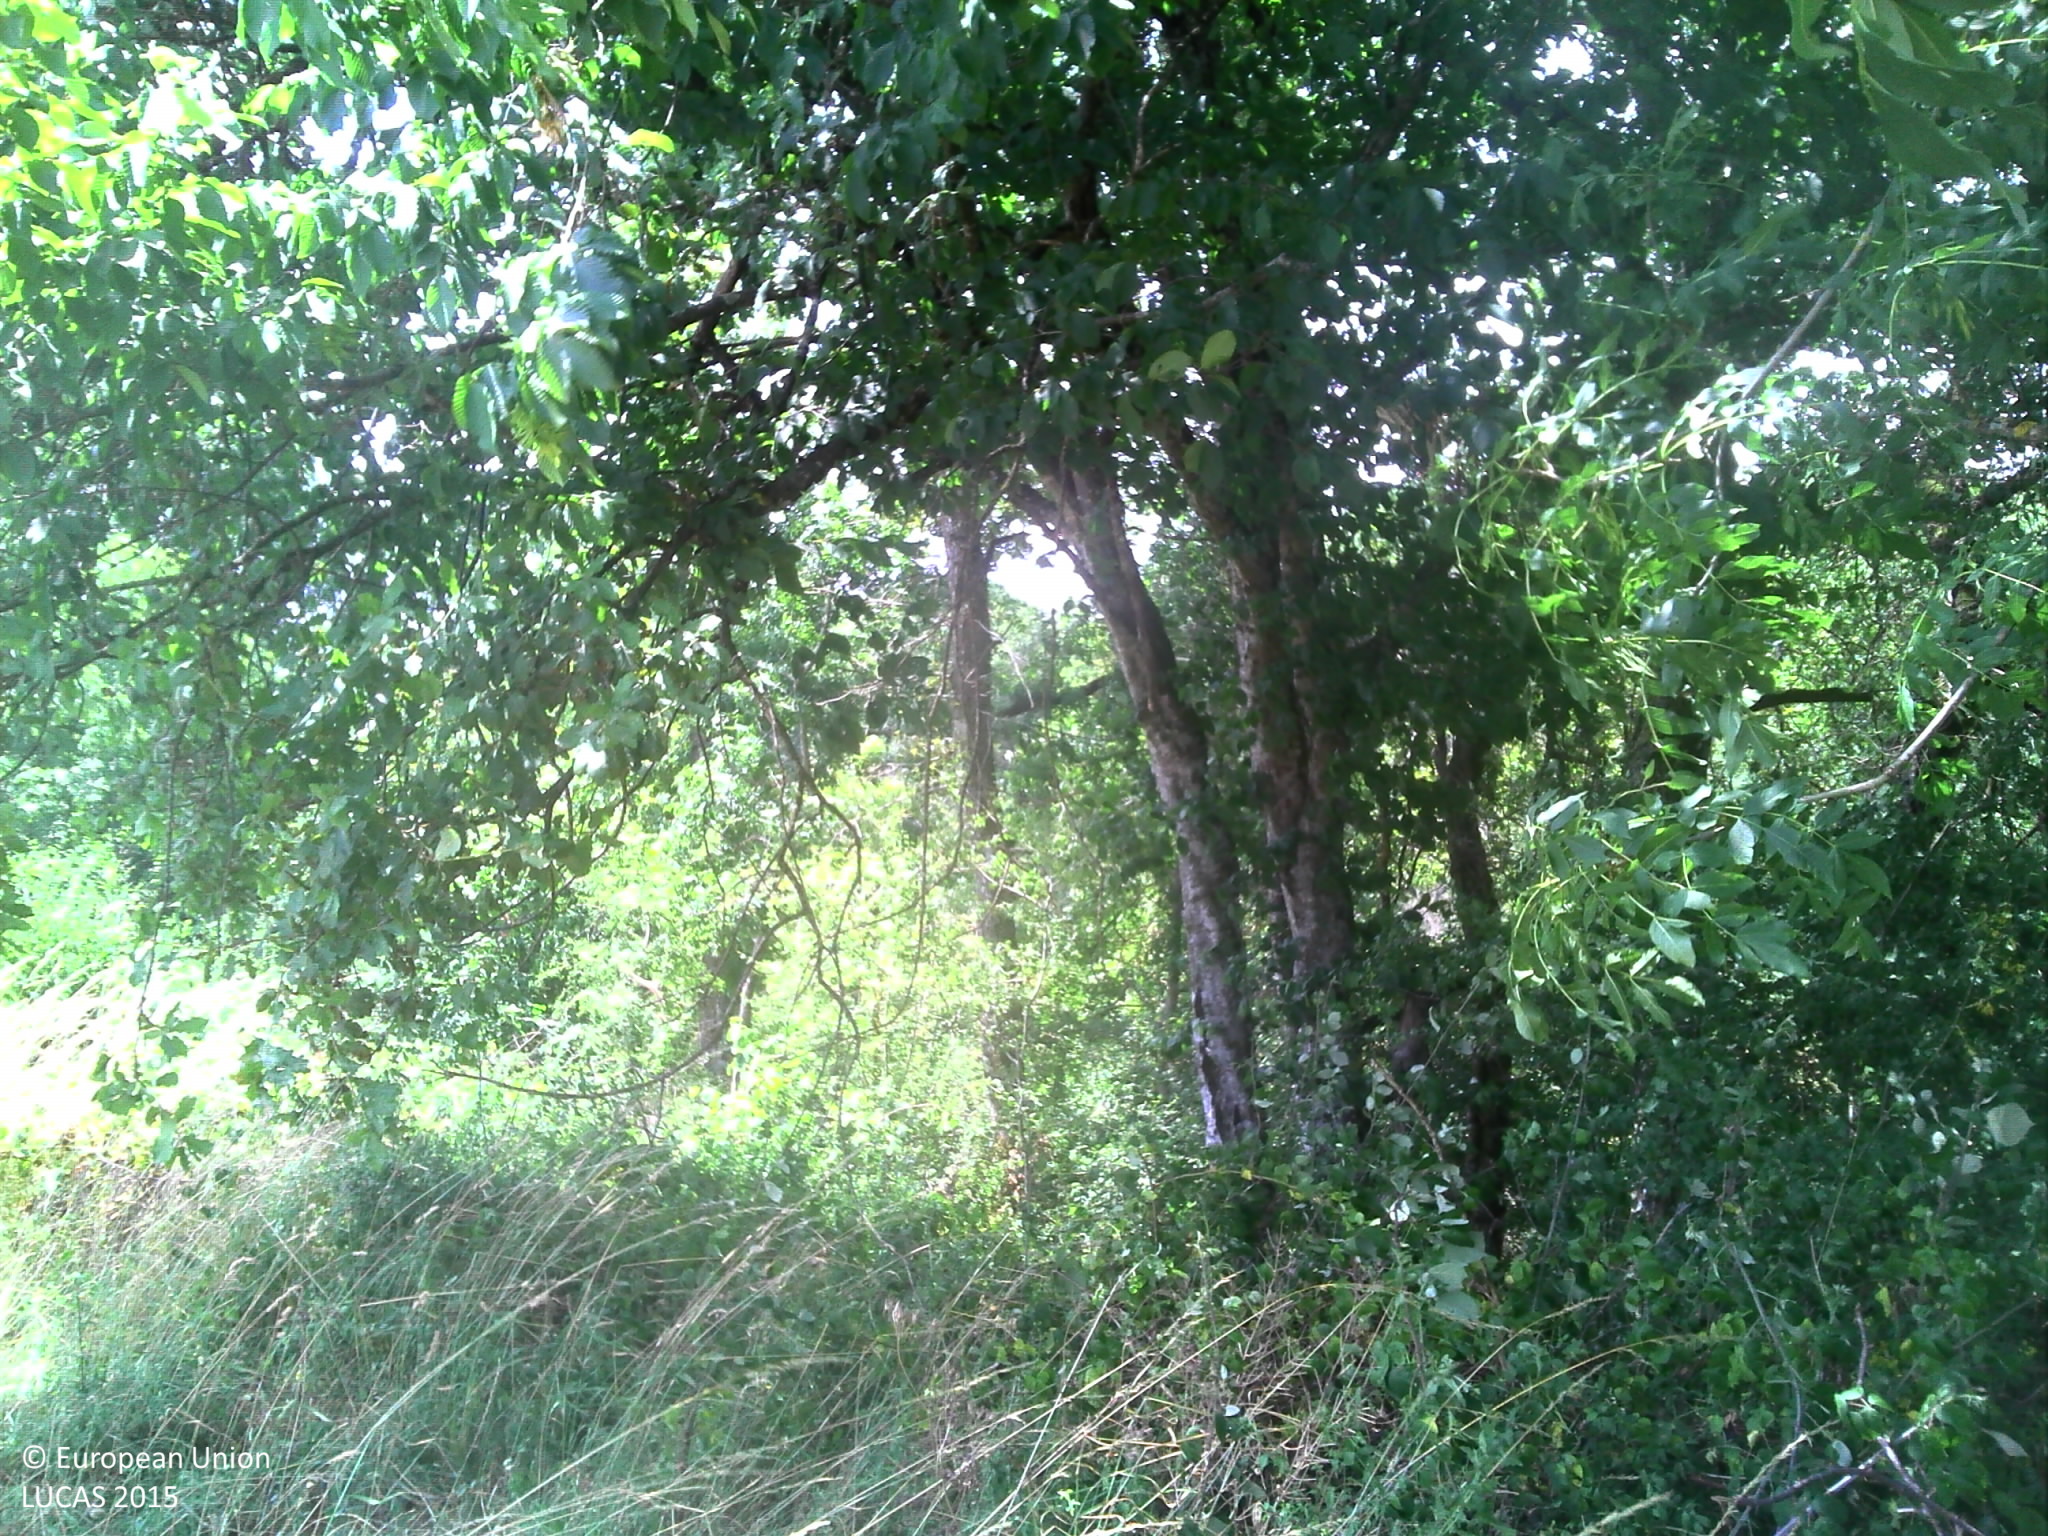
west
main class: Woodland
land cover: Broadleaved woodland
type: mesophytic deciduous forest
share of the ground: > 75 %
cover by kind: broadleaved forest trees 60 %, shrubs 20 %, herbaceous plants 20 %
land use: Forestry
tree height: > 5 m
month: July
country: FR
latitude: 45.7983
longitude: 5.3336
